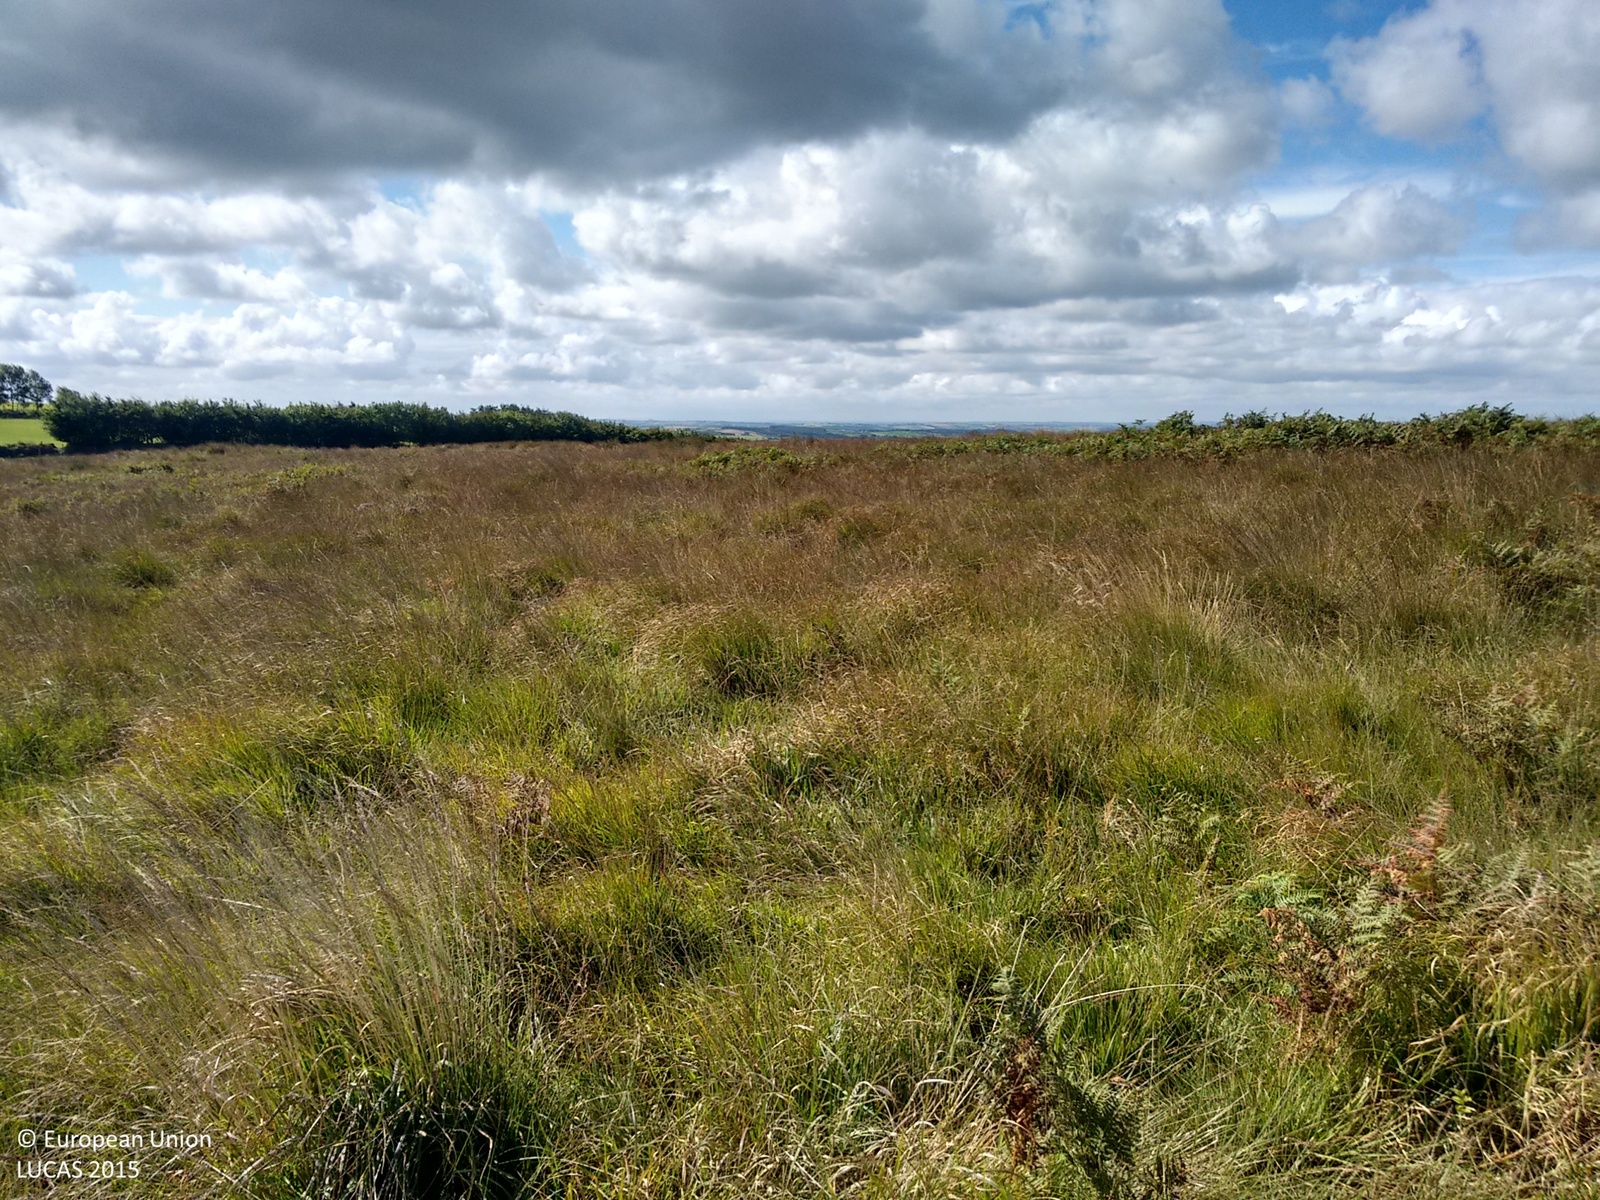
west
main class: Grassland
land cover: Grassland without tree/shrub cover
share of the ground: > 75 %
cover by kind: herbaceous plants 95 %, shrubs 5 %
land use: Agriculture (excluding fallow land and kitchen gardens)
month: September
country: GB
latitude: 51.0511
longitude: -3.6828
